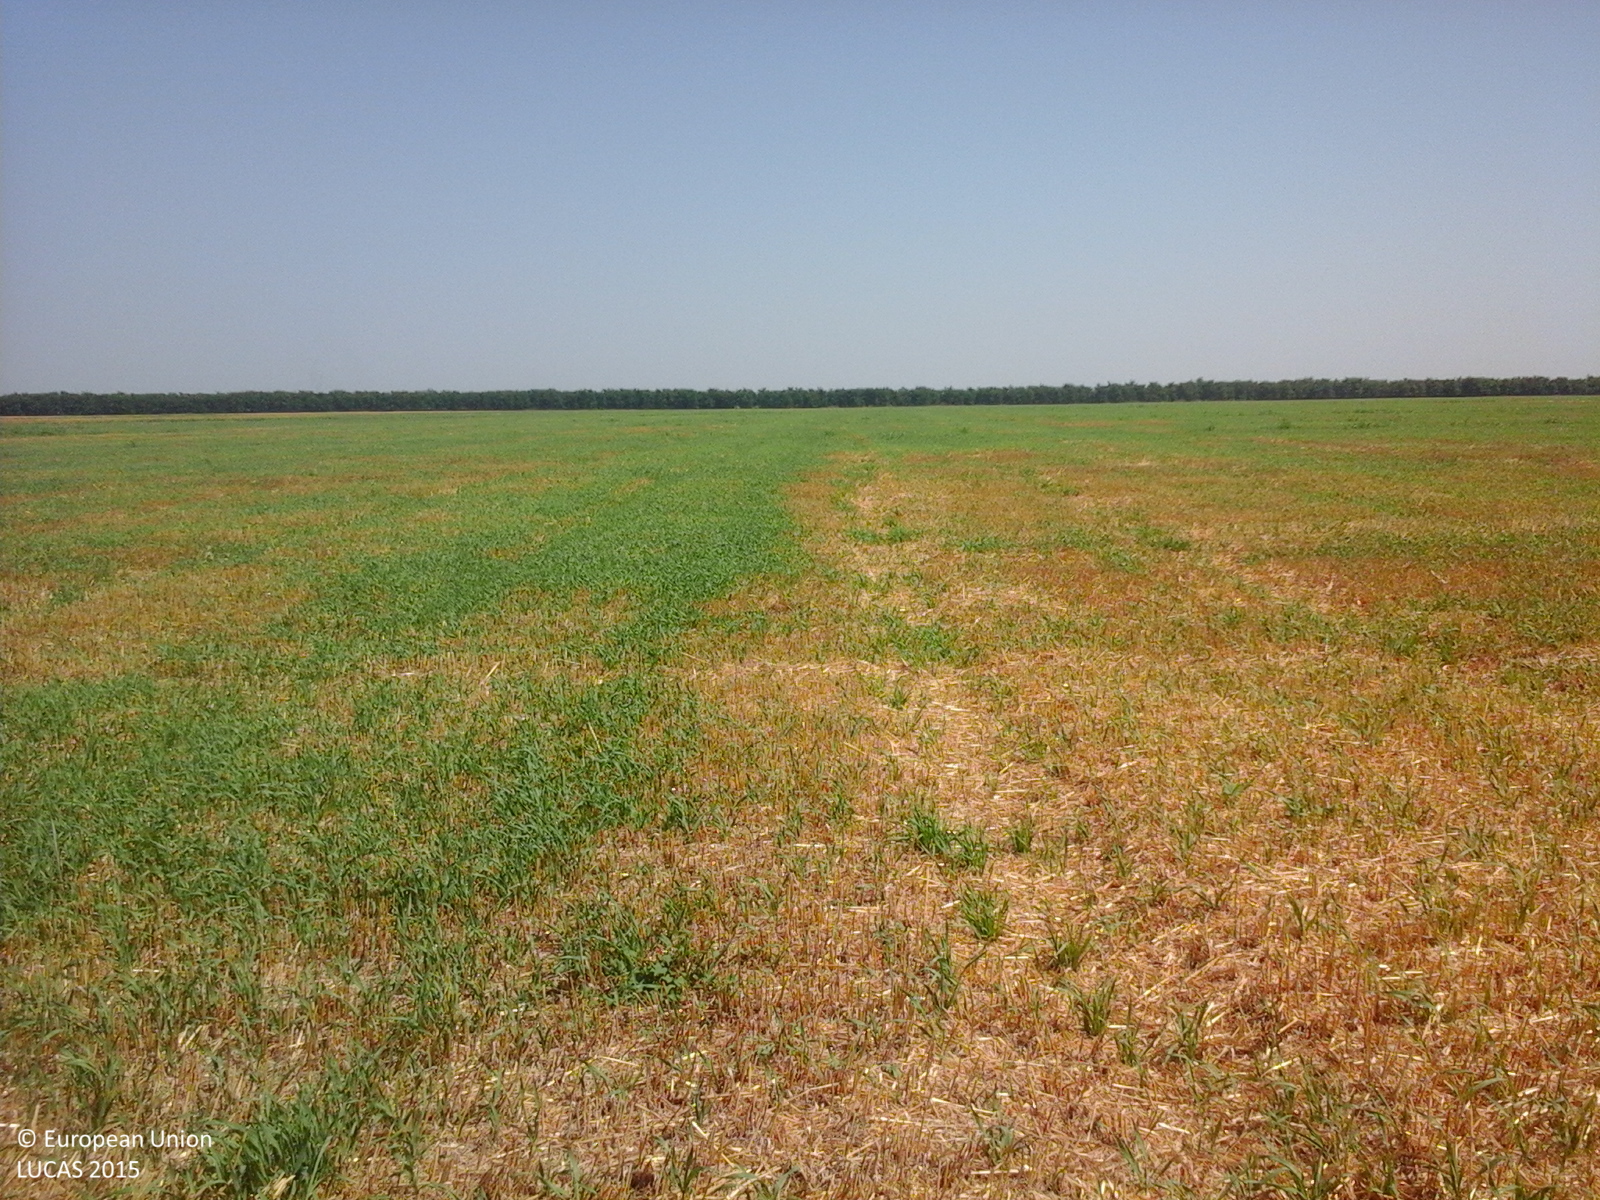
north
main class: Cropland
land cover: Durum wheat
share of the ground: > 75 %
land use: Agriculture (excluding fallow land and kitchen gardens)
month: July
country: RO
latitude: 44.5074
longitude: 27.2813
